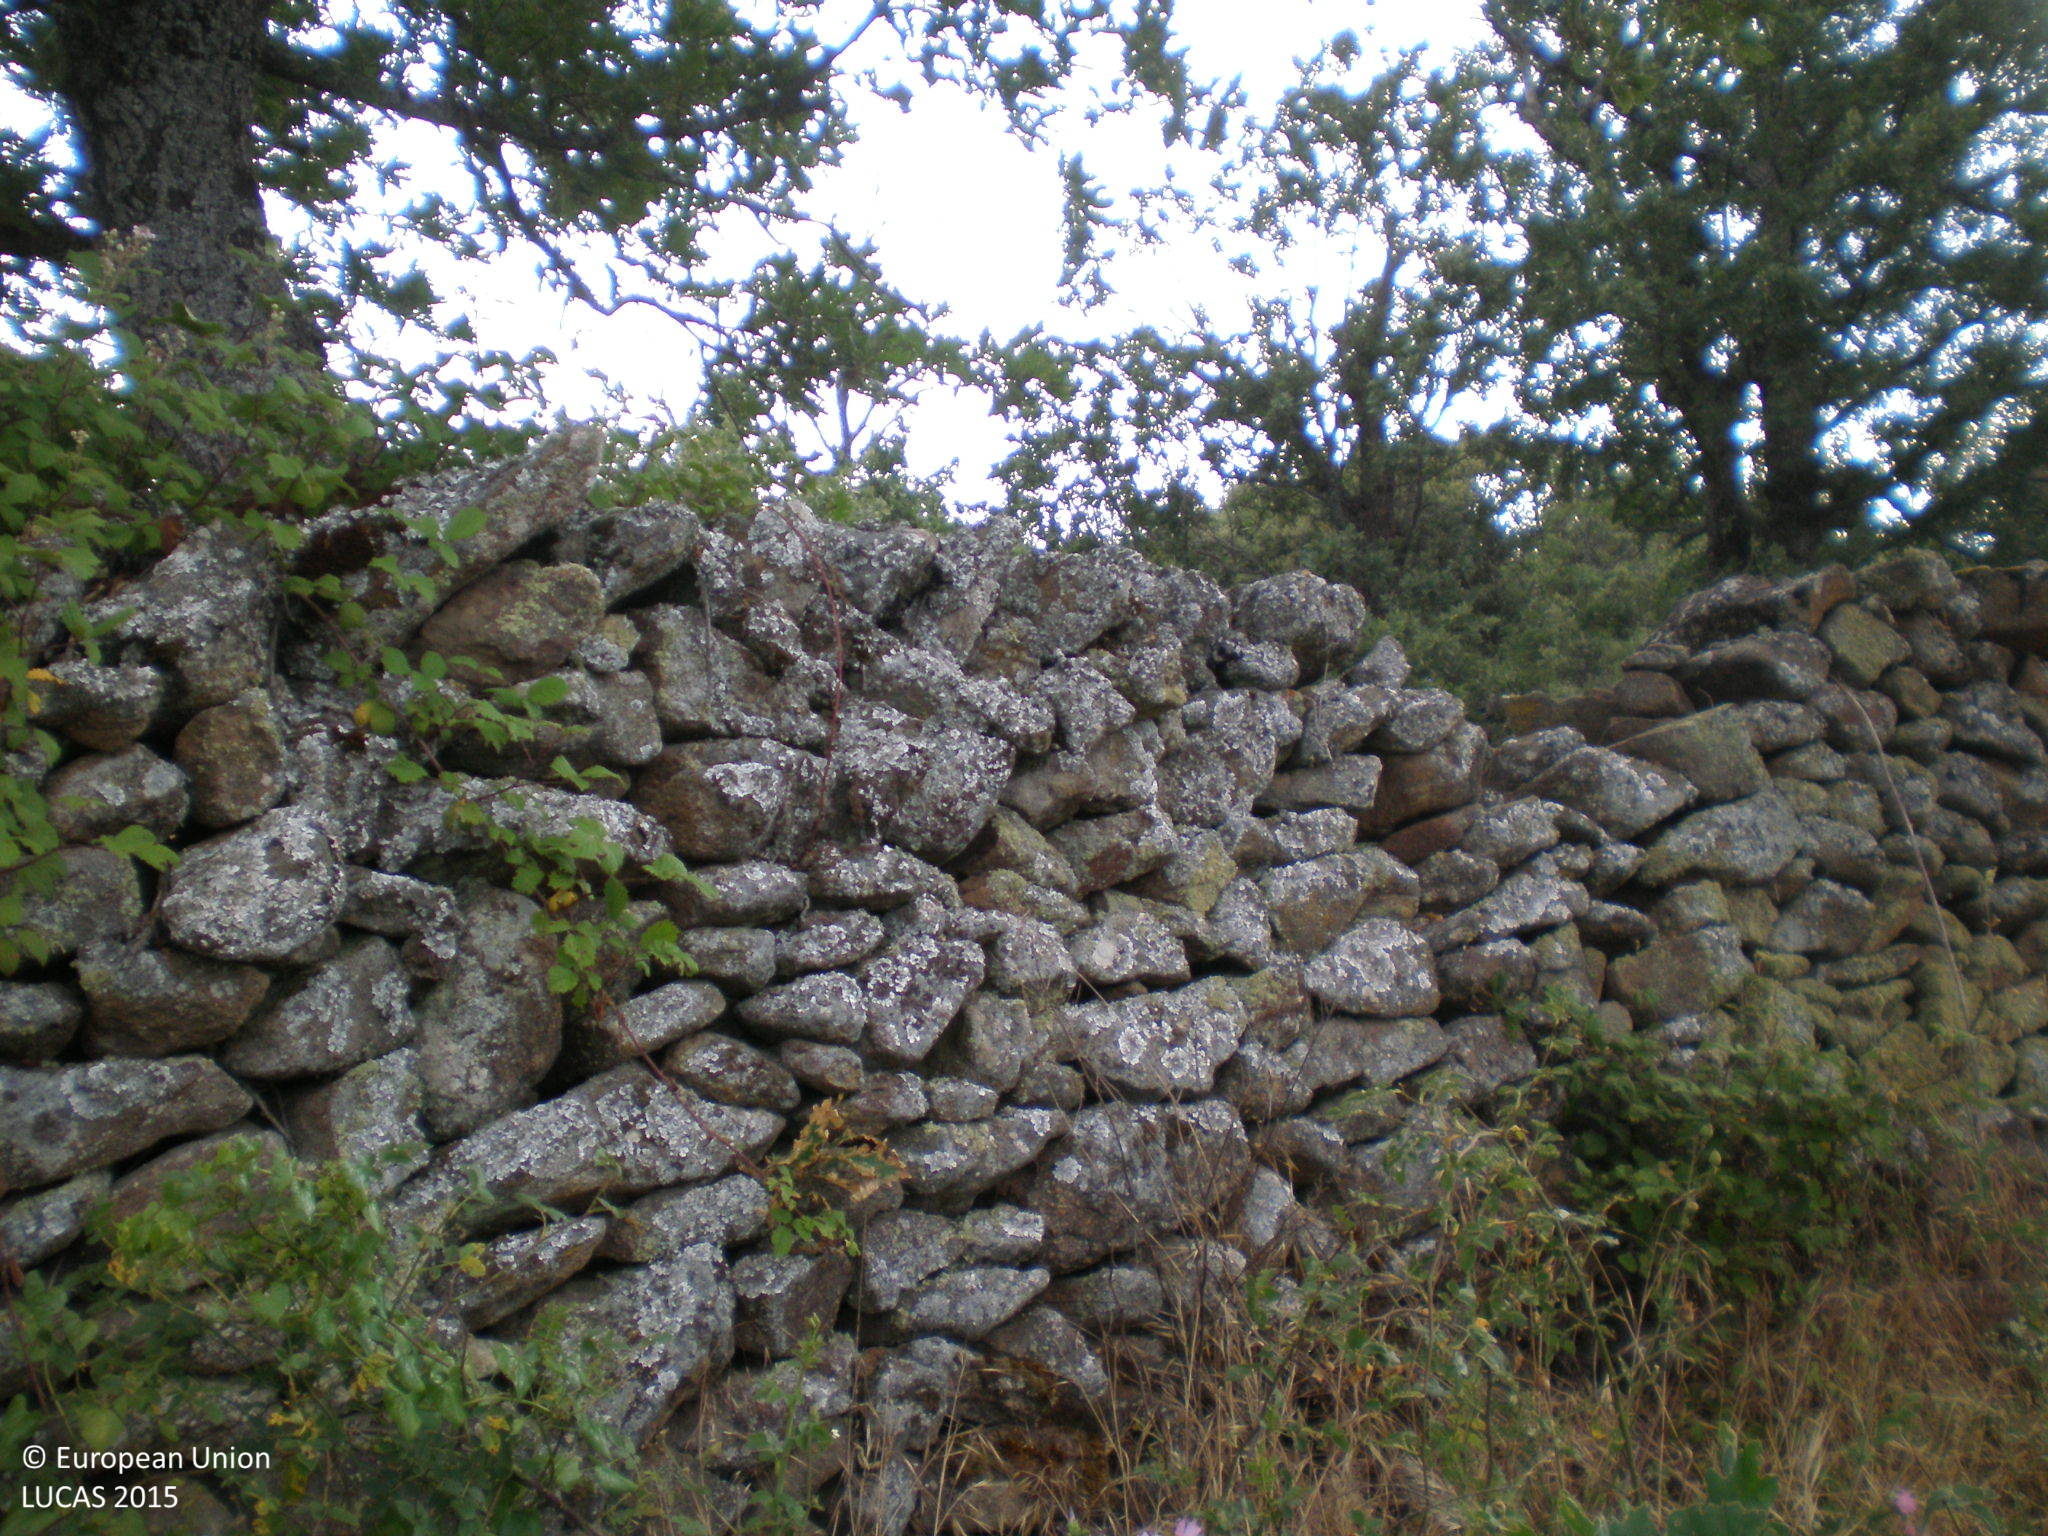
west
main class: Woodland
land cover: Broadleaved woodland
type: thermophilous deciduous forest
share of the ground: 10 - 25 %
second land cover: Grassland without tree/shrub cover
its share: > 75 %
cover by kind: herbaceous plants 85 %, broadleaved forest trees 15 %
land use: Forestry
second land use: Agriculture (excluding fallow land and kitchen gardens)
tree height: > 5 m
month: June
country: ES
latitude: 40.3821
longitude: -5.5322
